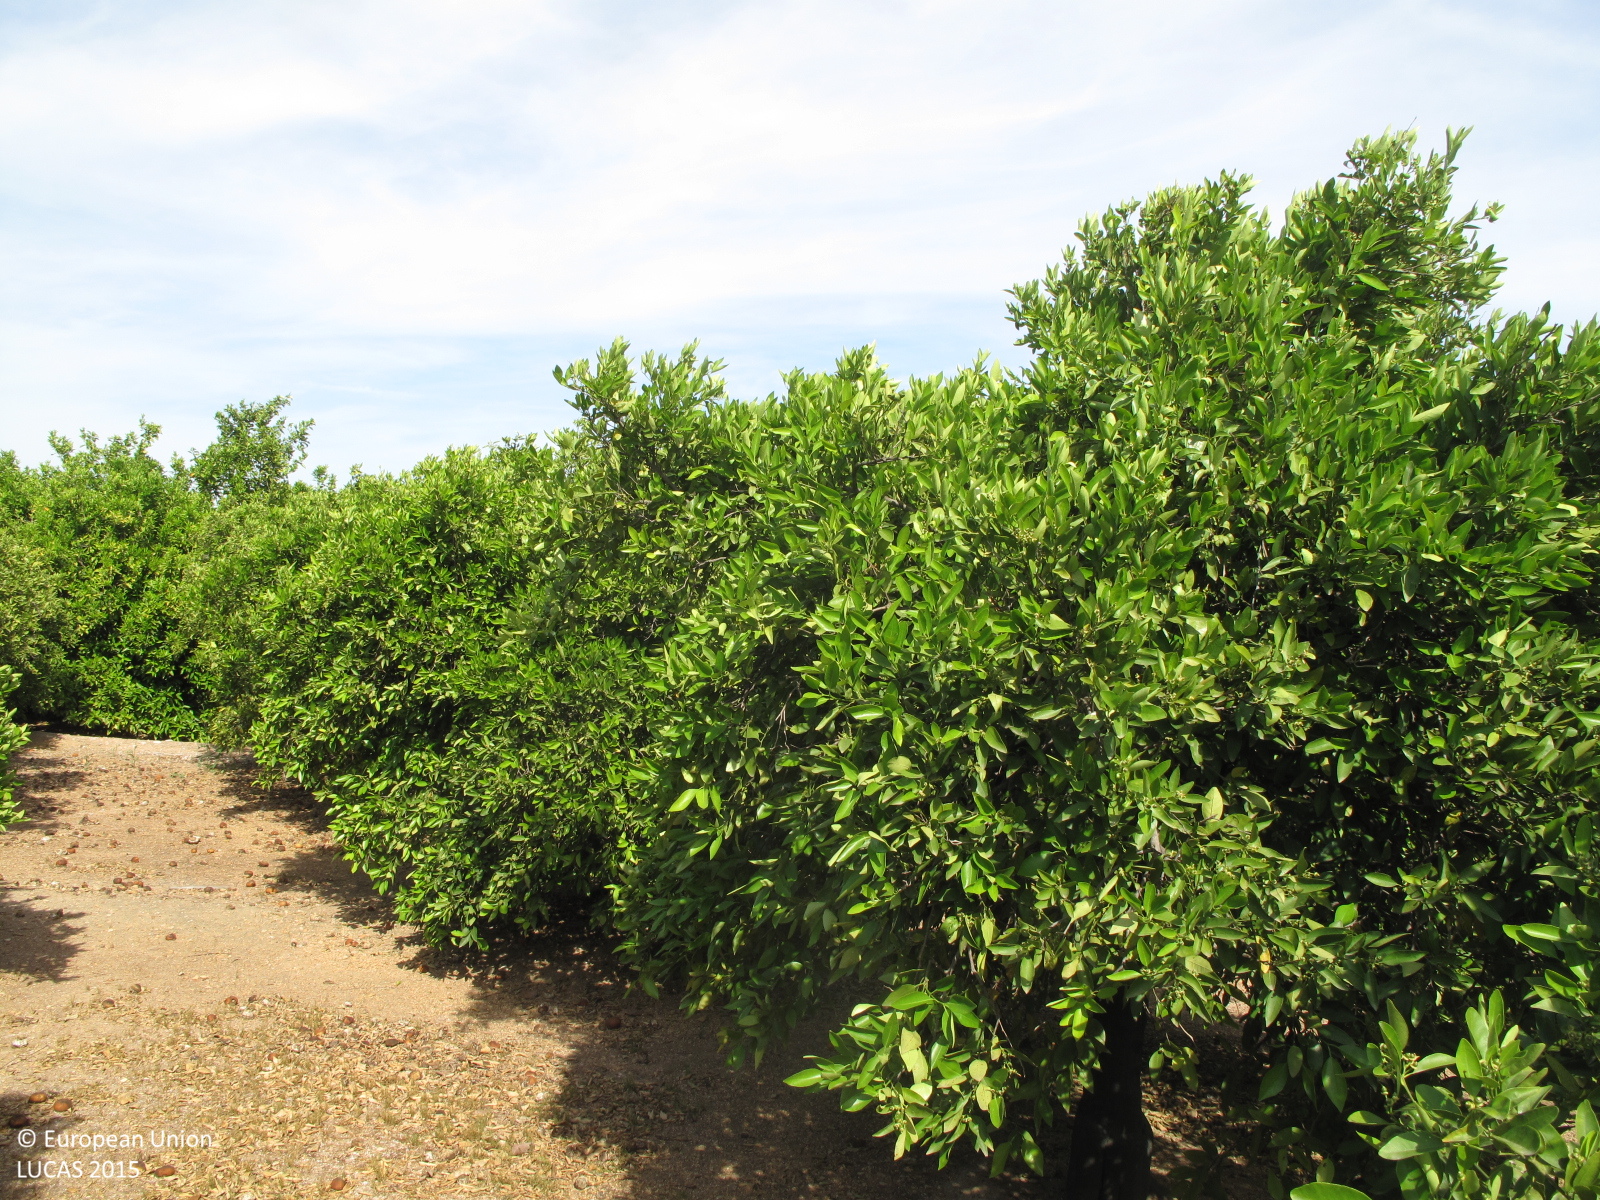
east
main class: Cropland
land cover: Oranges
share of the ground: > 75 %
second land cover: Other bare soil
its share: > 75 %
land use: Agriculture (excluding fallow land and kitchen gardens)
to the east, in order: Oranges; Other bare soil; Grass margins; Tracks; Ditches and canals; Oranges; Ditches and canals; Fences; Artificial constructions in urban areas; Fences; Grass margins; Tracks; Oranges; Ditches and canals; Oranges
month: May
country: ES
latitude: 39.0720
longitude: -0.5930
